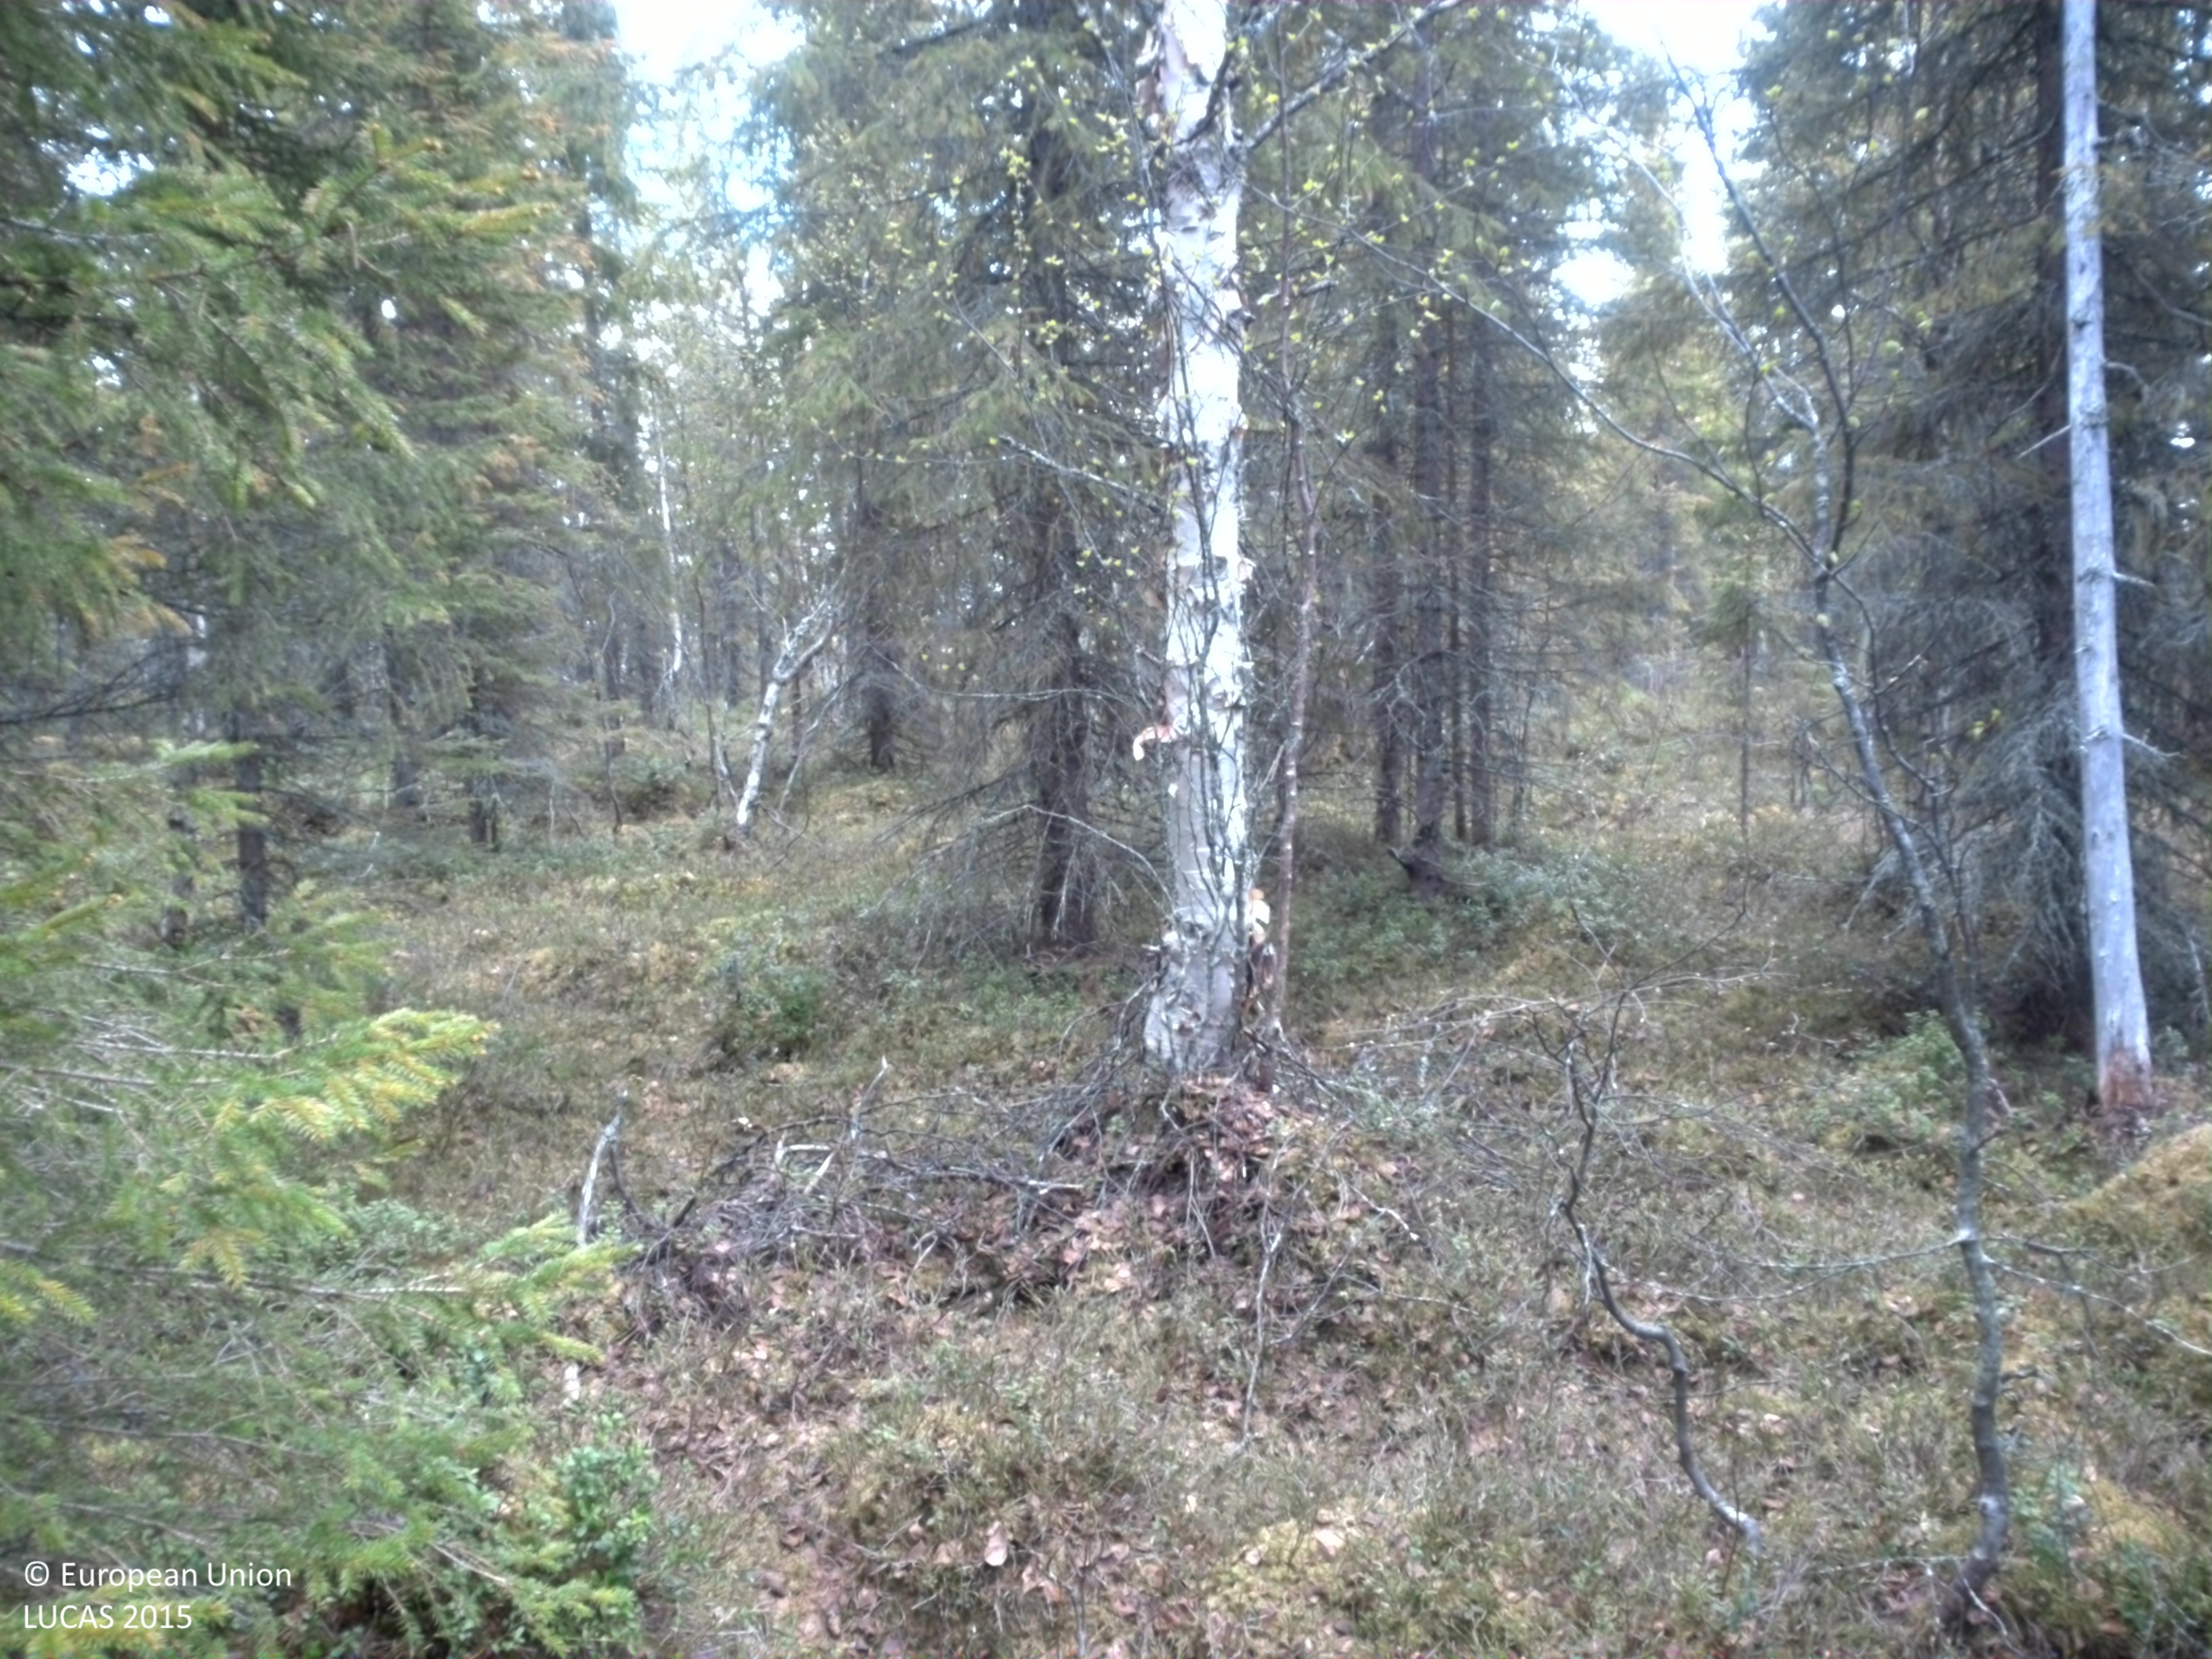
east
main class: Woodland
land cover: Spruce dominated coniferous woodland
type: boreal forest
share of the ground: 50 - 75 %
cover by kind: coniferous forest trees 55 %, herbaceous plants 20 %, lichens and mosses 15 %, broadleaved forest trees 5 %, shrubs 5 %
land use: Forestry
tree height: > 5 m
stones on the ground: < 10 %
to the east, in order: Spruce dominated coniferous woodland; Grassland with sparse tree/shrub cover; Broadleaved woodland
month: June
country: SE
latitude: 64.3143
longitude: 18.1785
